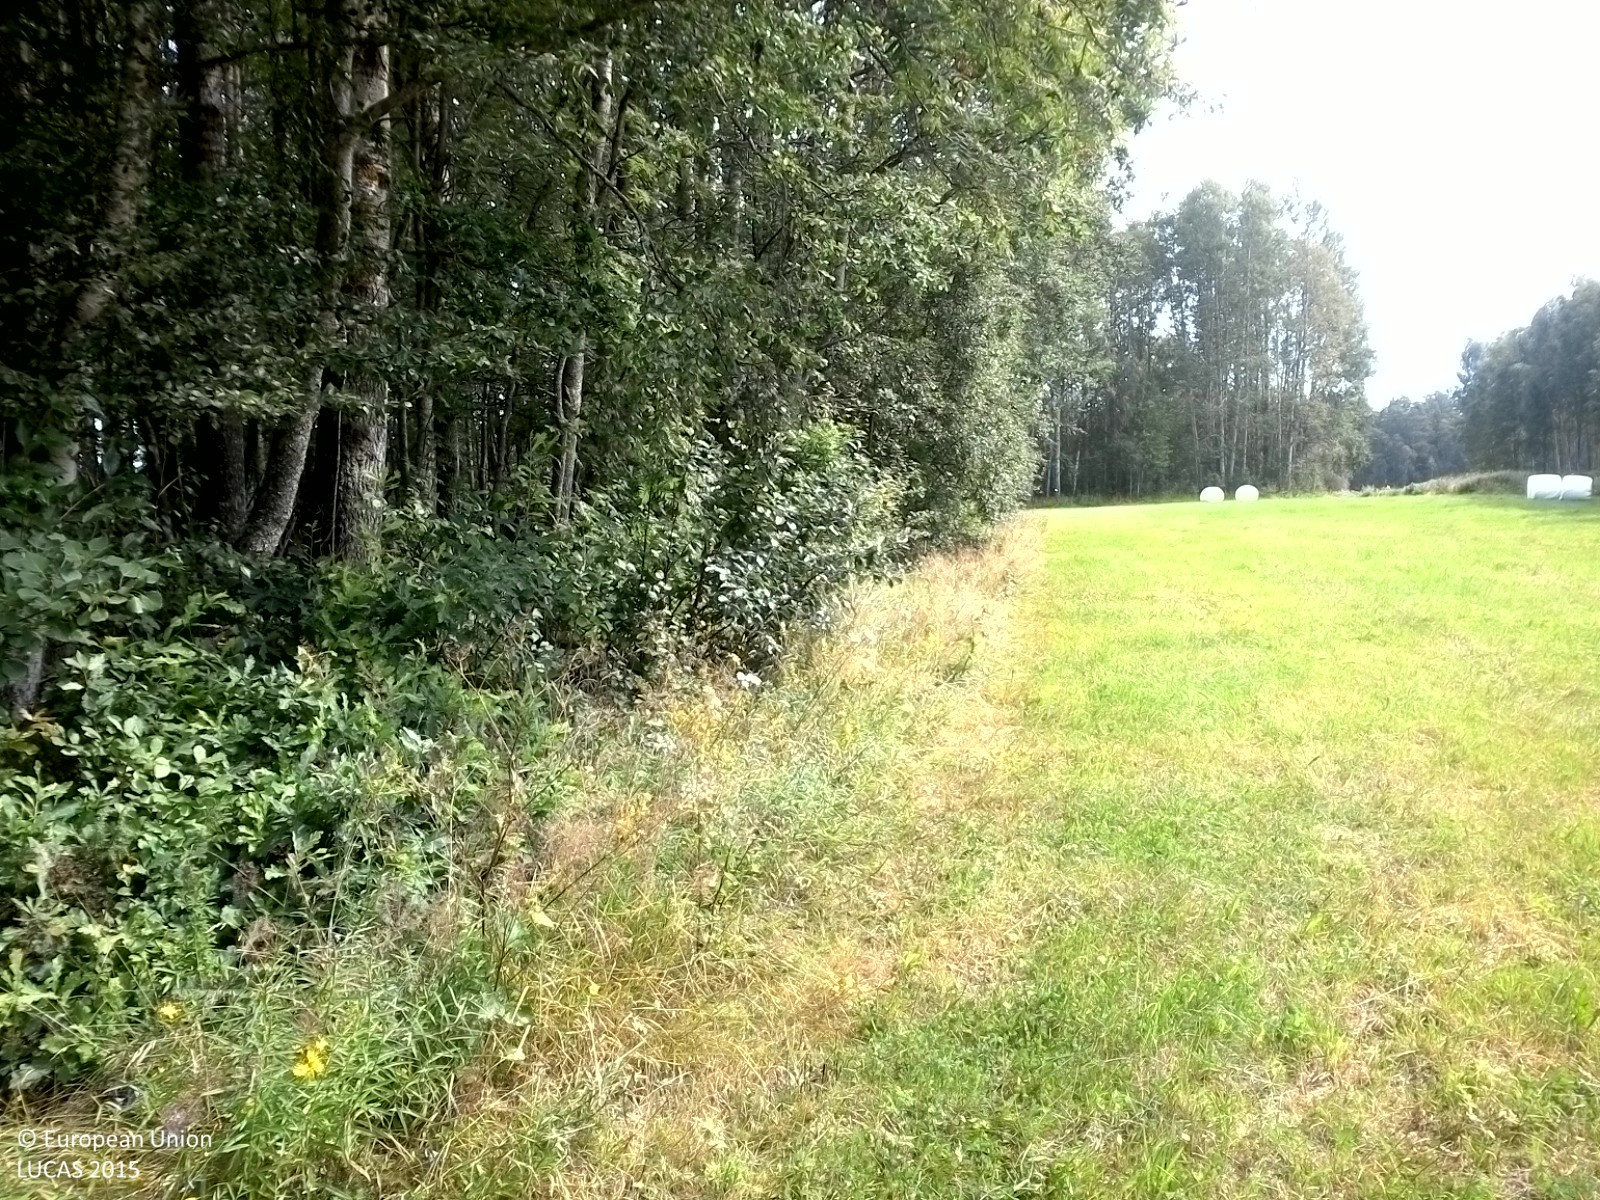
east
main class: Cropland
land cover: Temporary grasslands
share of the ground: > 75 %
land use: Agriculture (excluding fallow land and kitchen gardens)
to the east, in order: Temporary grasslands; Broadleaved woodland; Temporary grasslands; Broadleaved woodland; Temporary grasslands; Paved roads, cycling and walking lanes; Grass margins; Fences; Grassland without tree/shrub cover
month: August
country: SE
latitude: 59.0703
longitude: 14.8238
